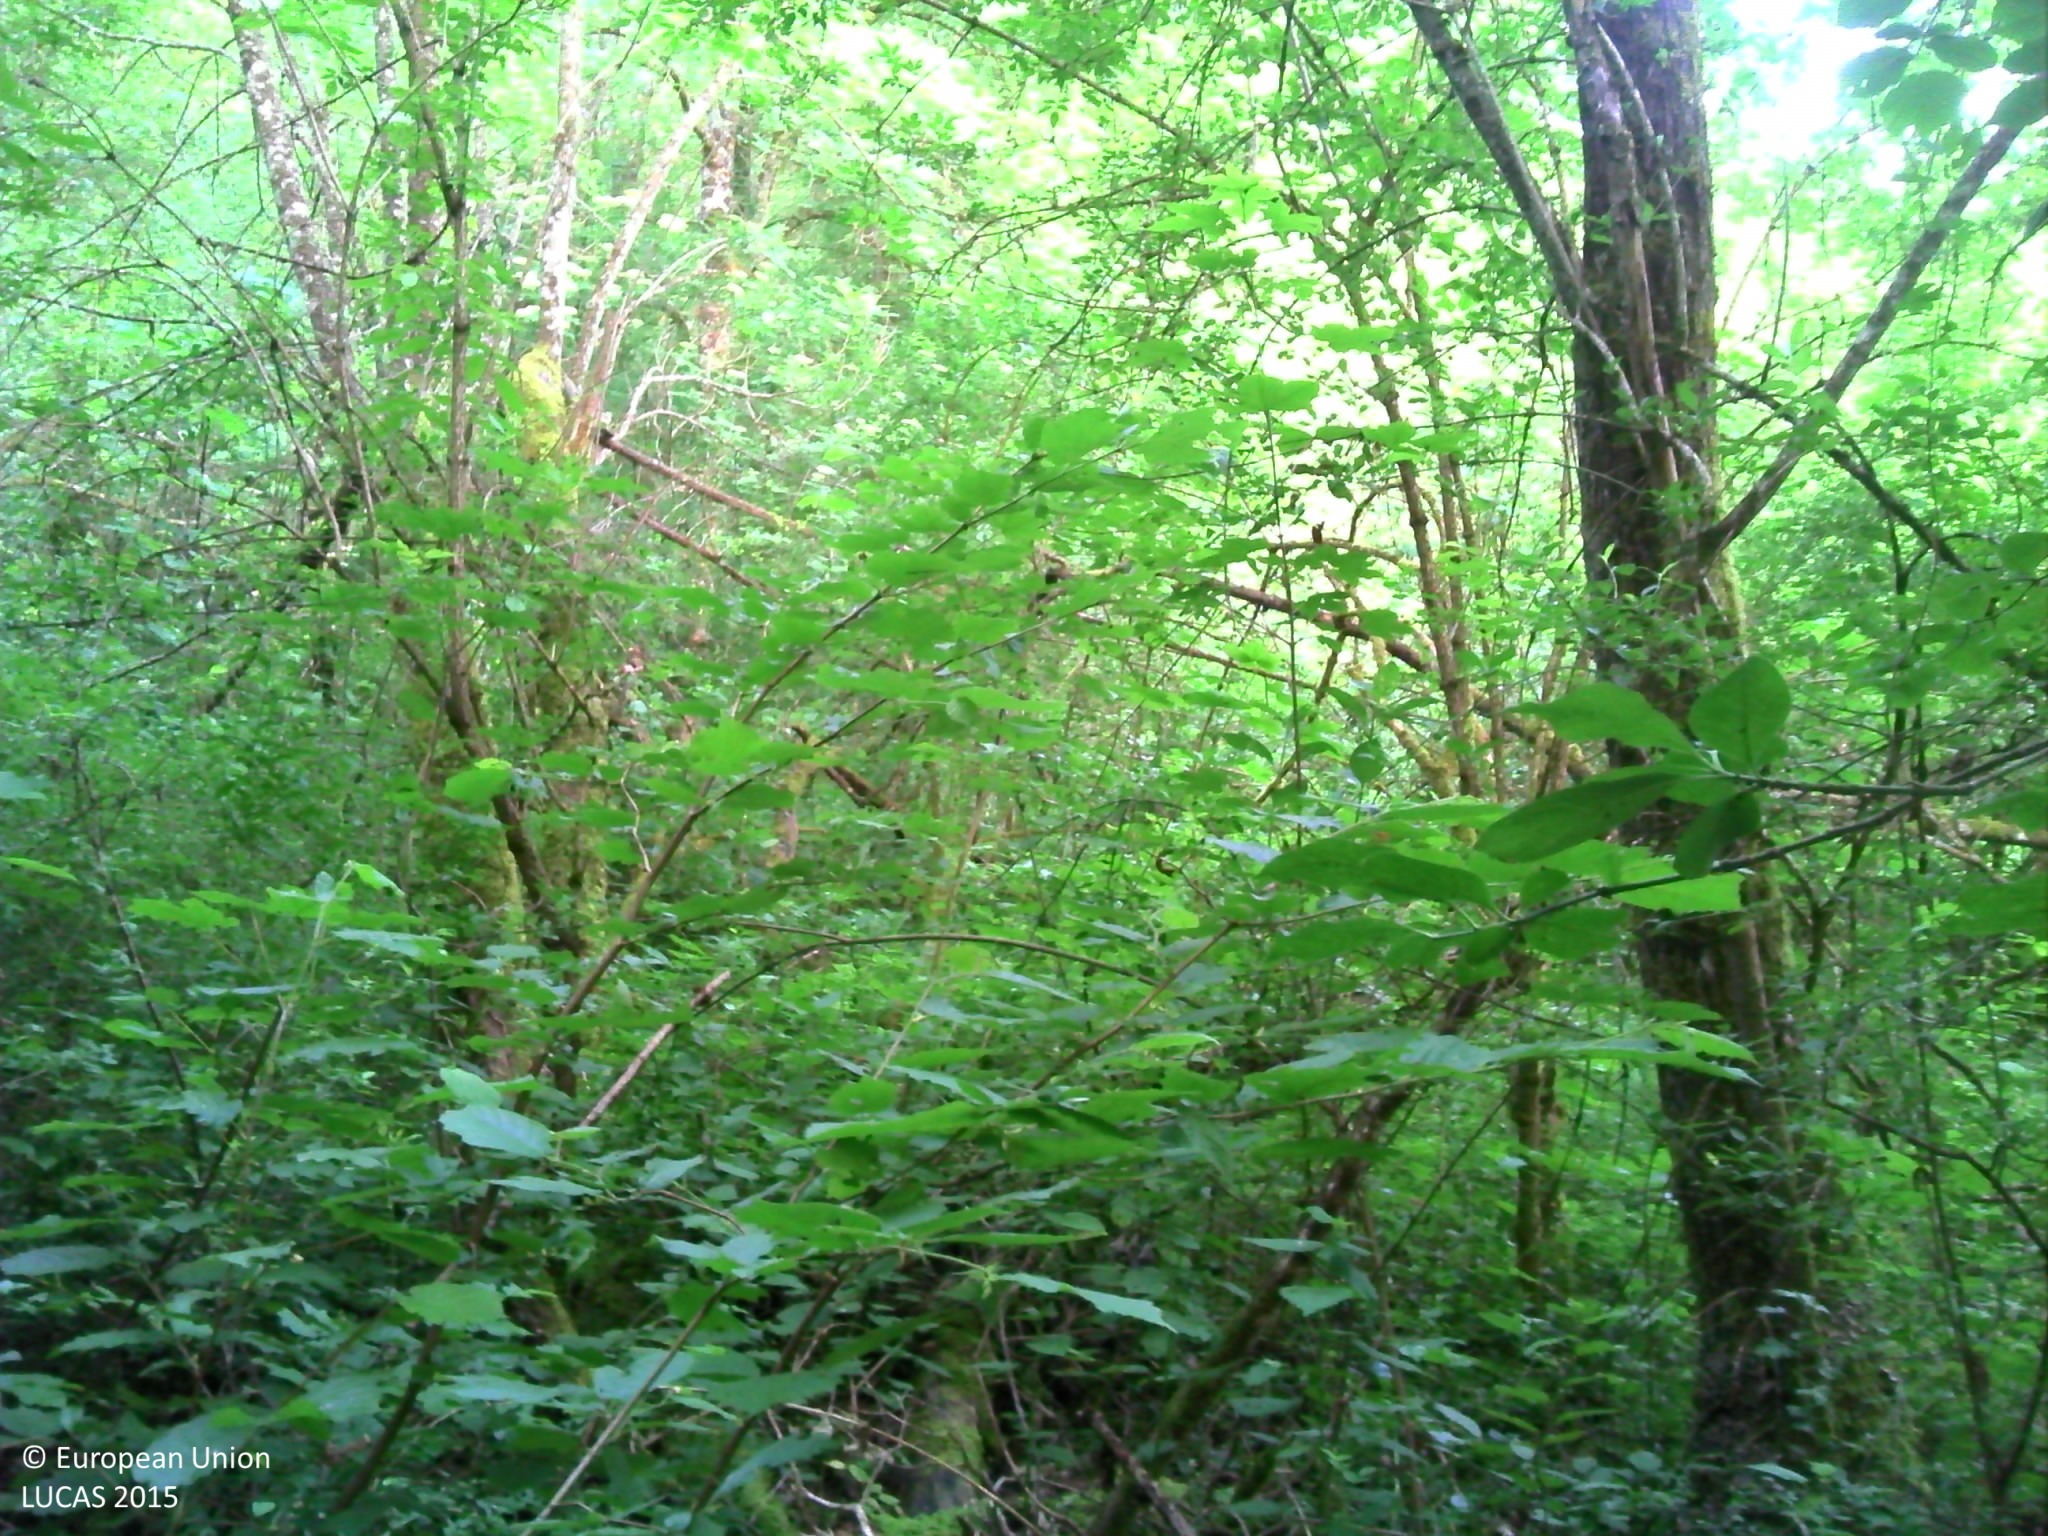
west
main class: Woodland
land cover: Broadleaved woodland
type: beech forest
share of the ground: > 75 %
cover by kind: broadleaved forest trees 90 %, herbaceous plants 10 %
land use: Forestry
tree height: > 5 m
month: June
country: FR
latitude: 47.7428
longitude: 6.1735
